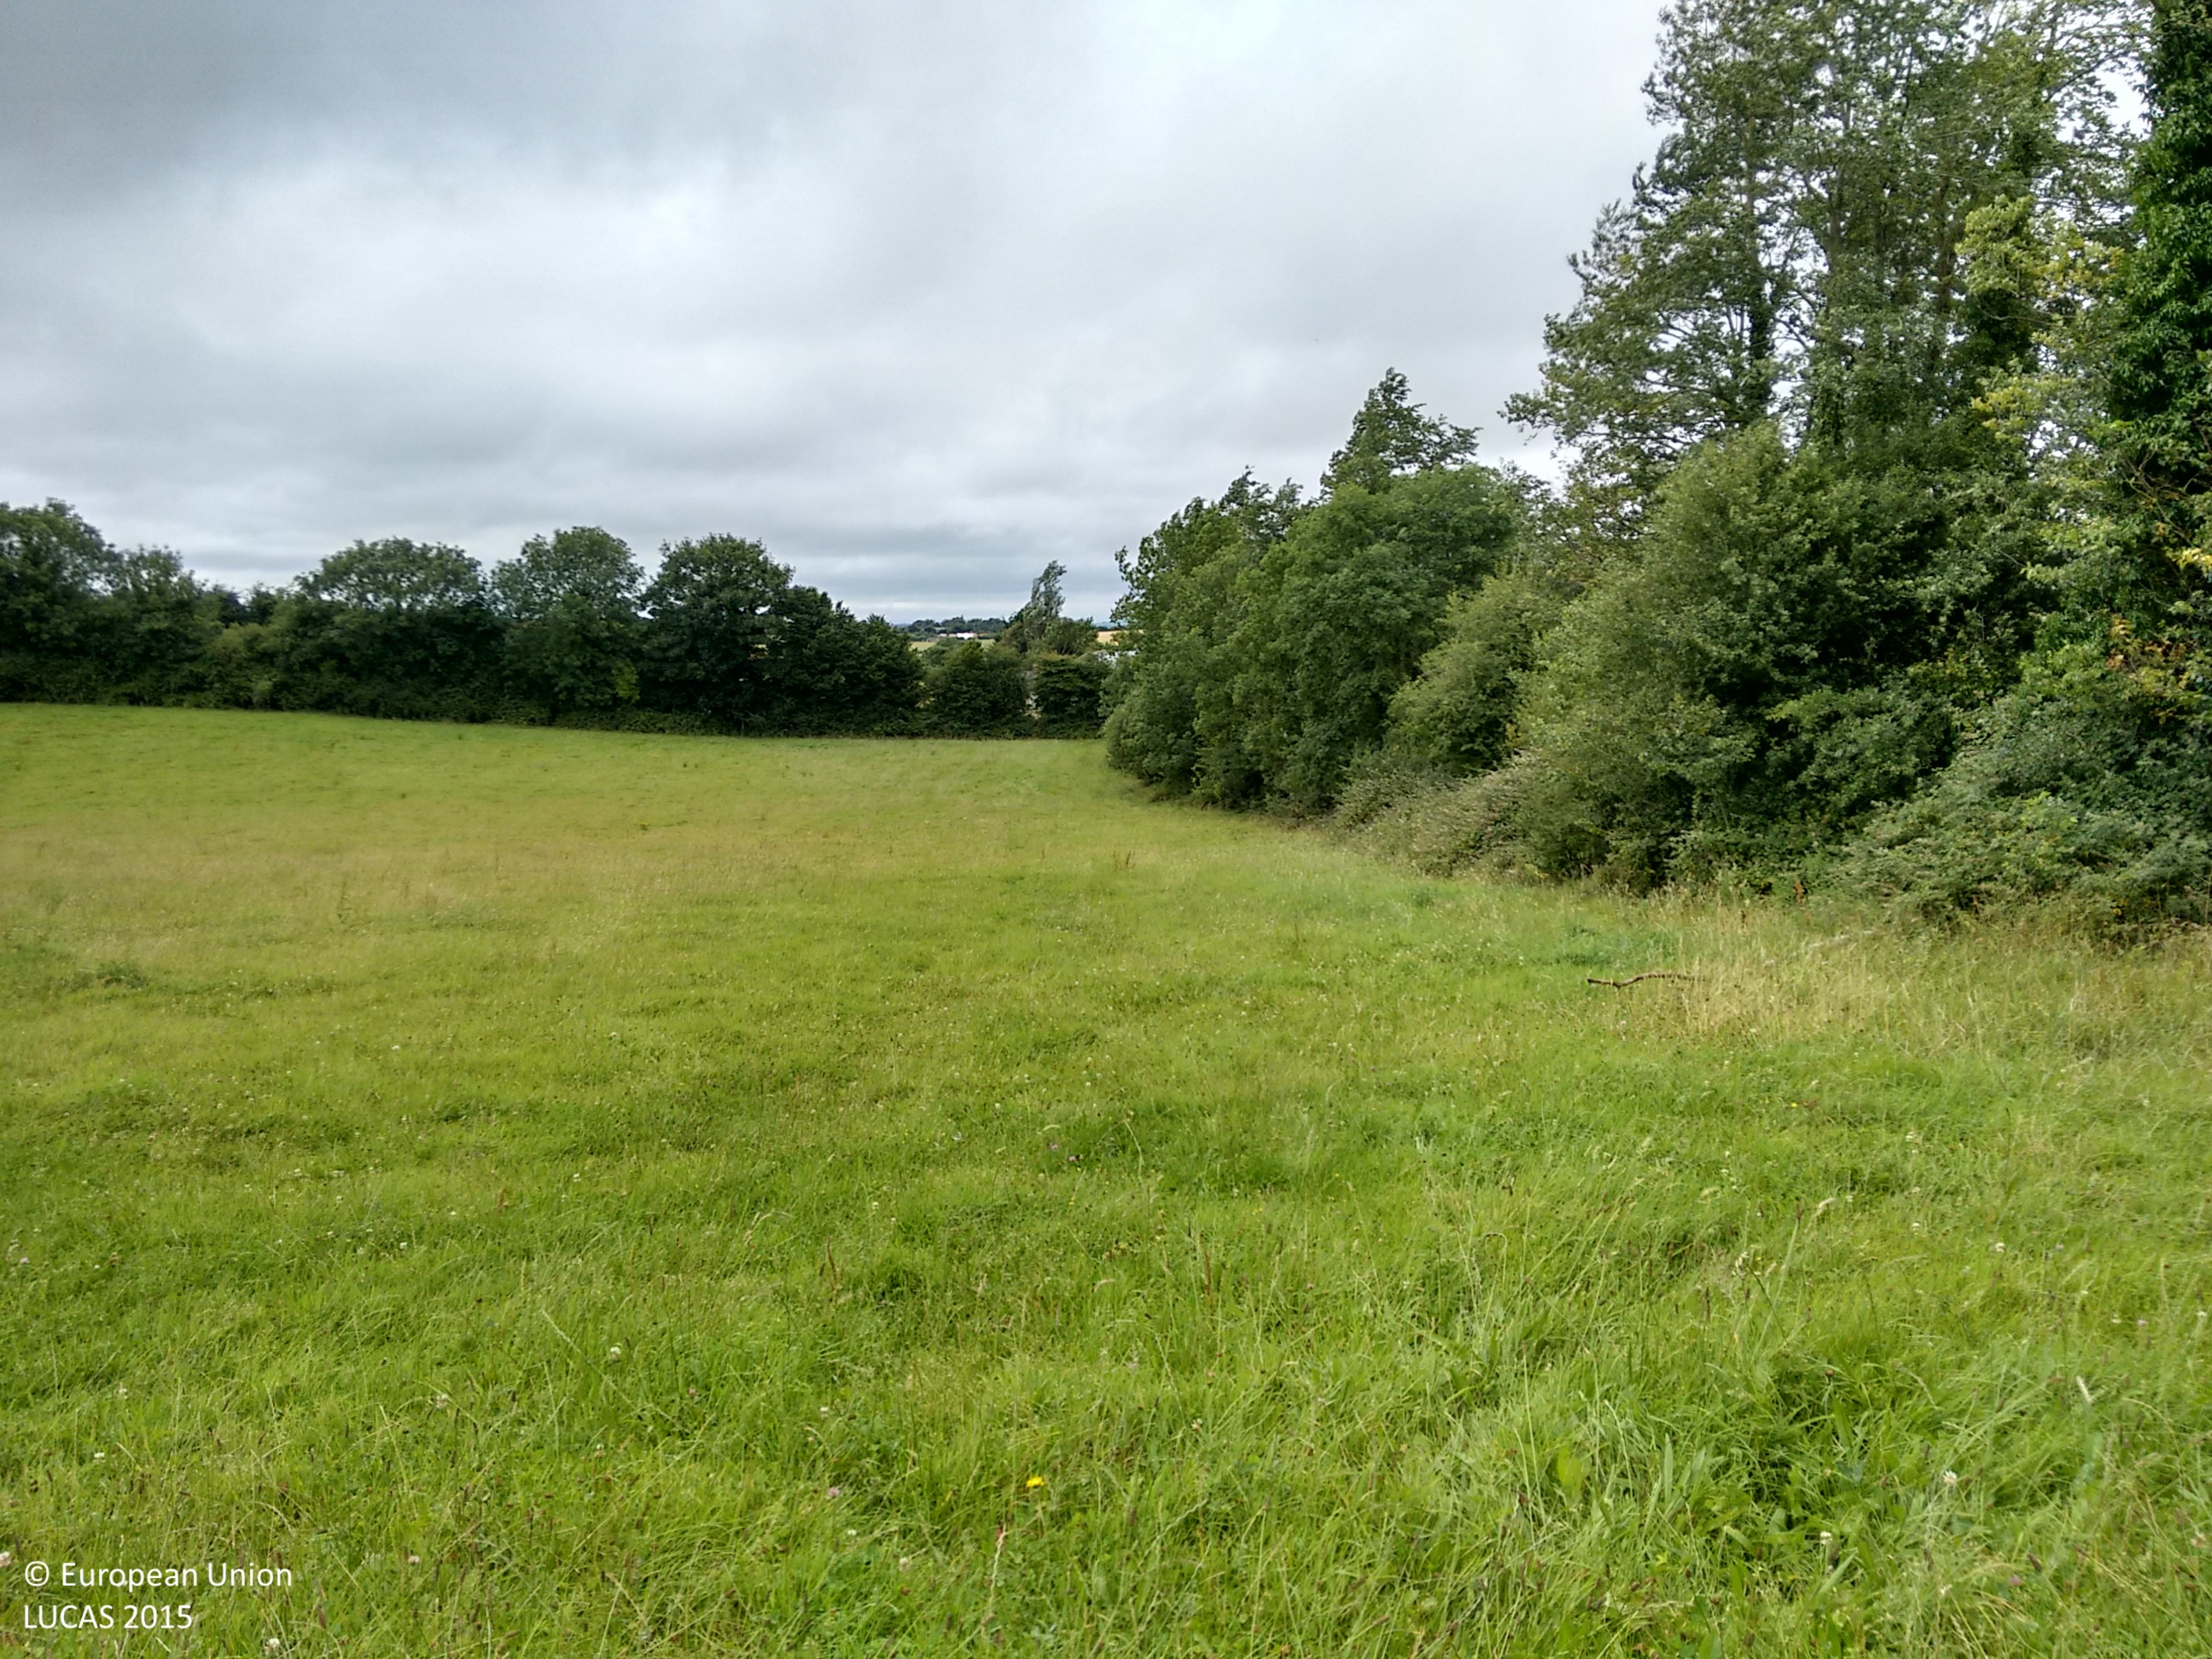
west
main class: Grassland
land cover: Grassland without tree/shrub cover
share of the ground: > 75 %
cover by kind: herbaceous plants 100 %
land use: Agriculture (excluding fallow land and kitchen gardens)
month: August
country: IE
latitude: 52.8729
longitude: -7.3431
